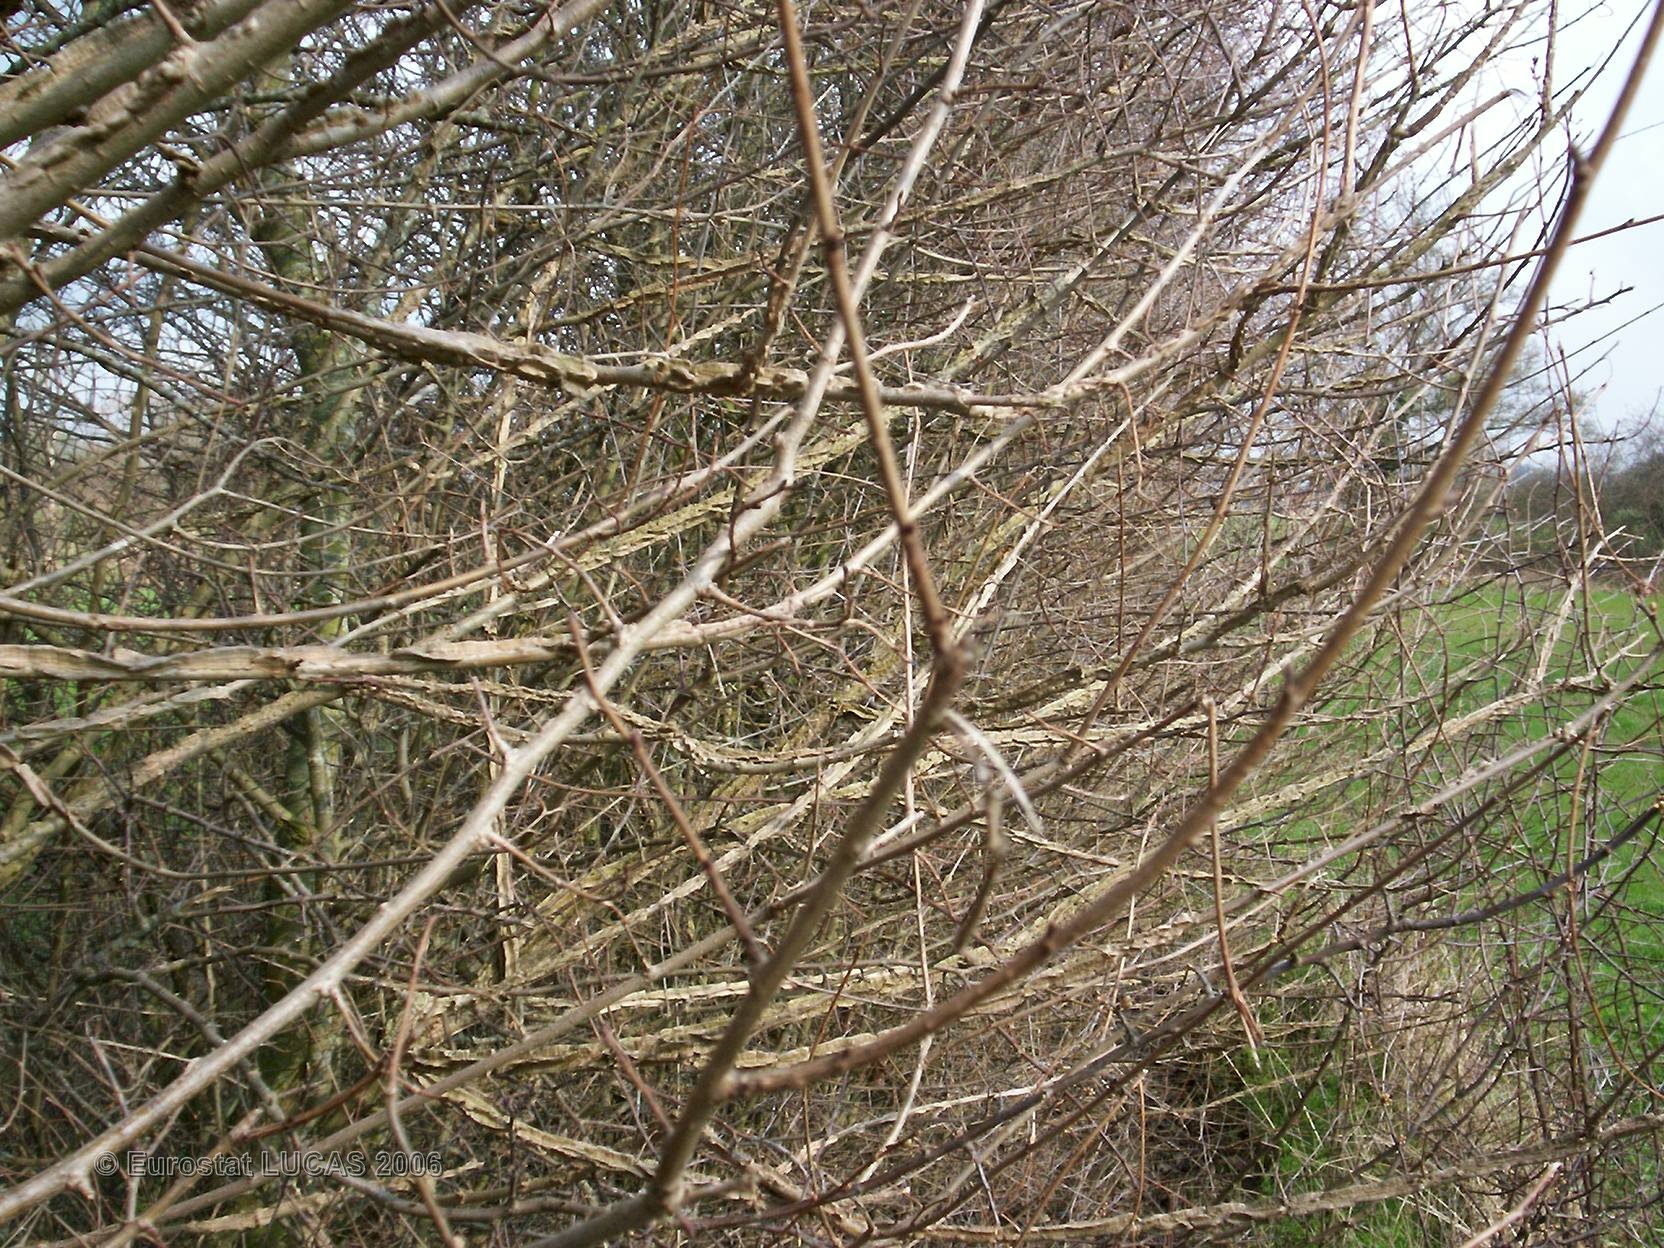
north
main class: Grassland
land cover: Grassland without tree/shrub cover
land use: Agriculture (excluding fallow land and kitchen gardens)
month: April
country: FR
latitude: 48.9119
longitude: 0.0227
